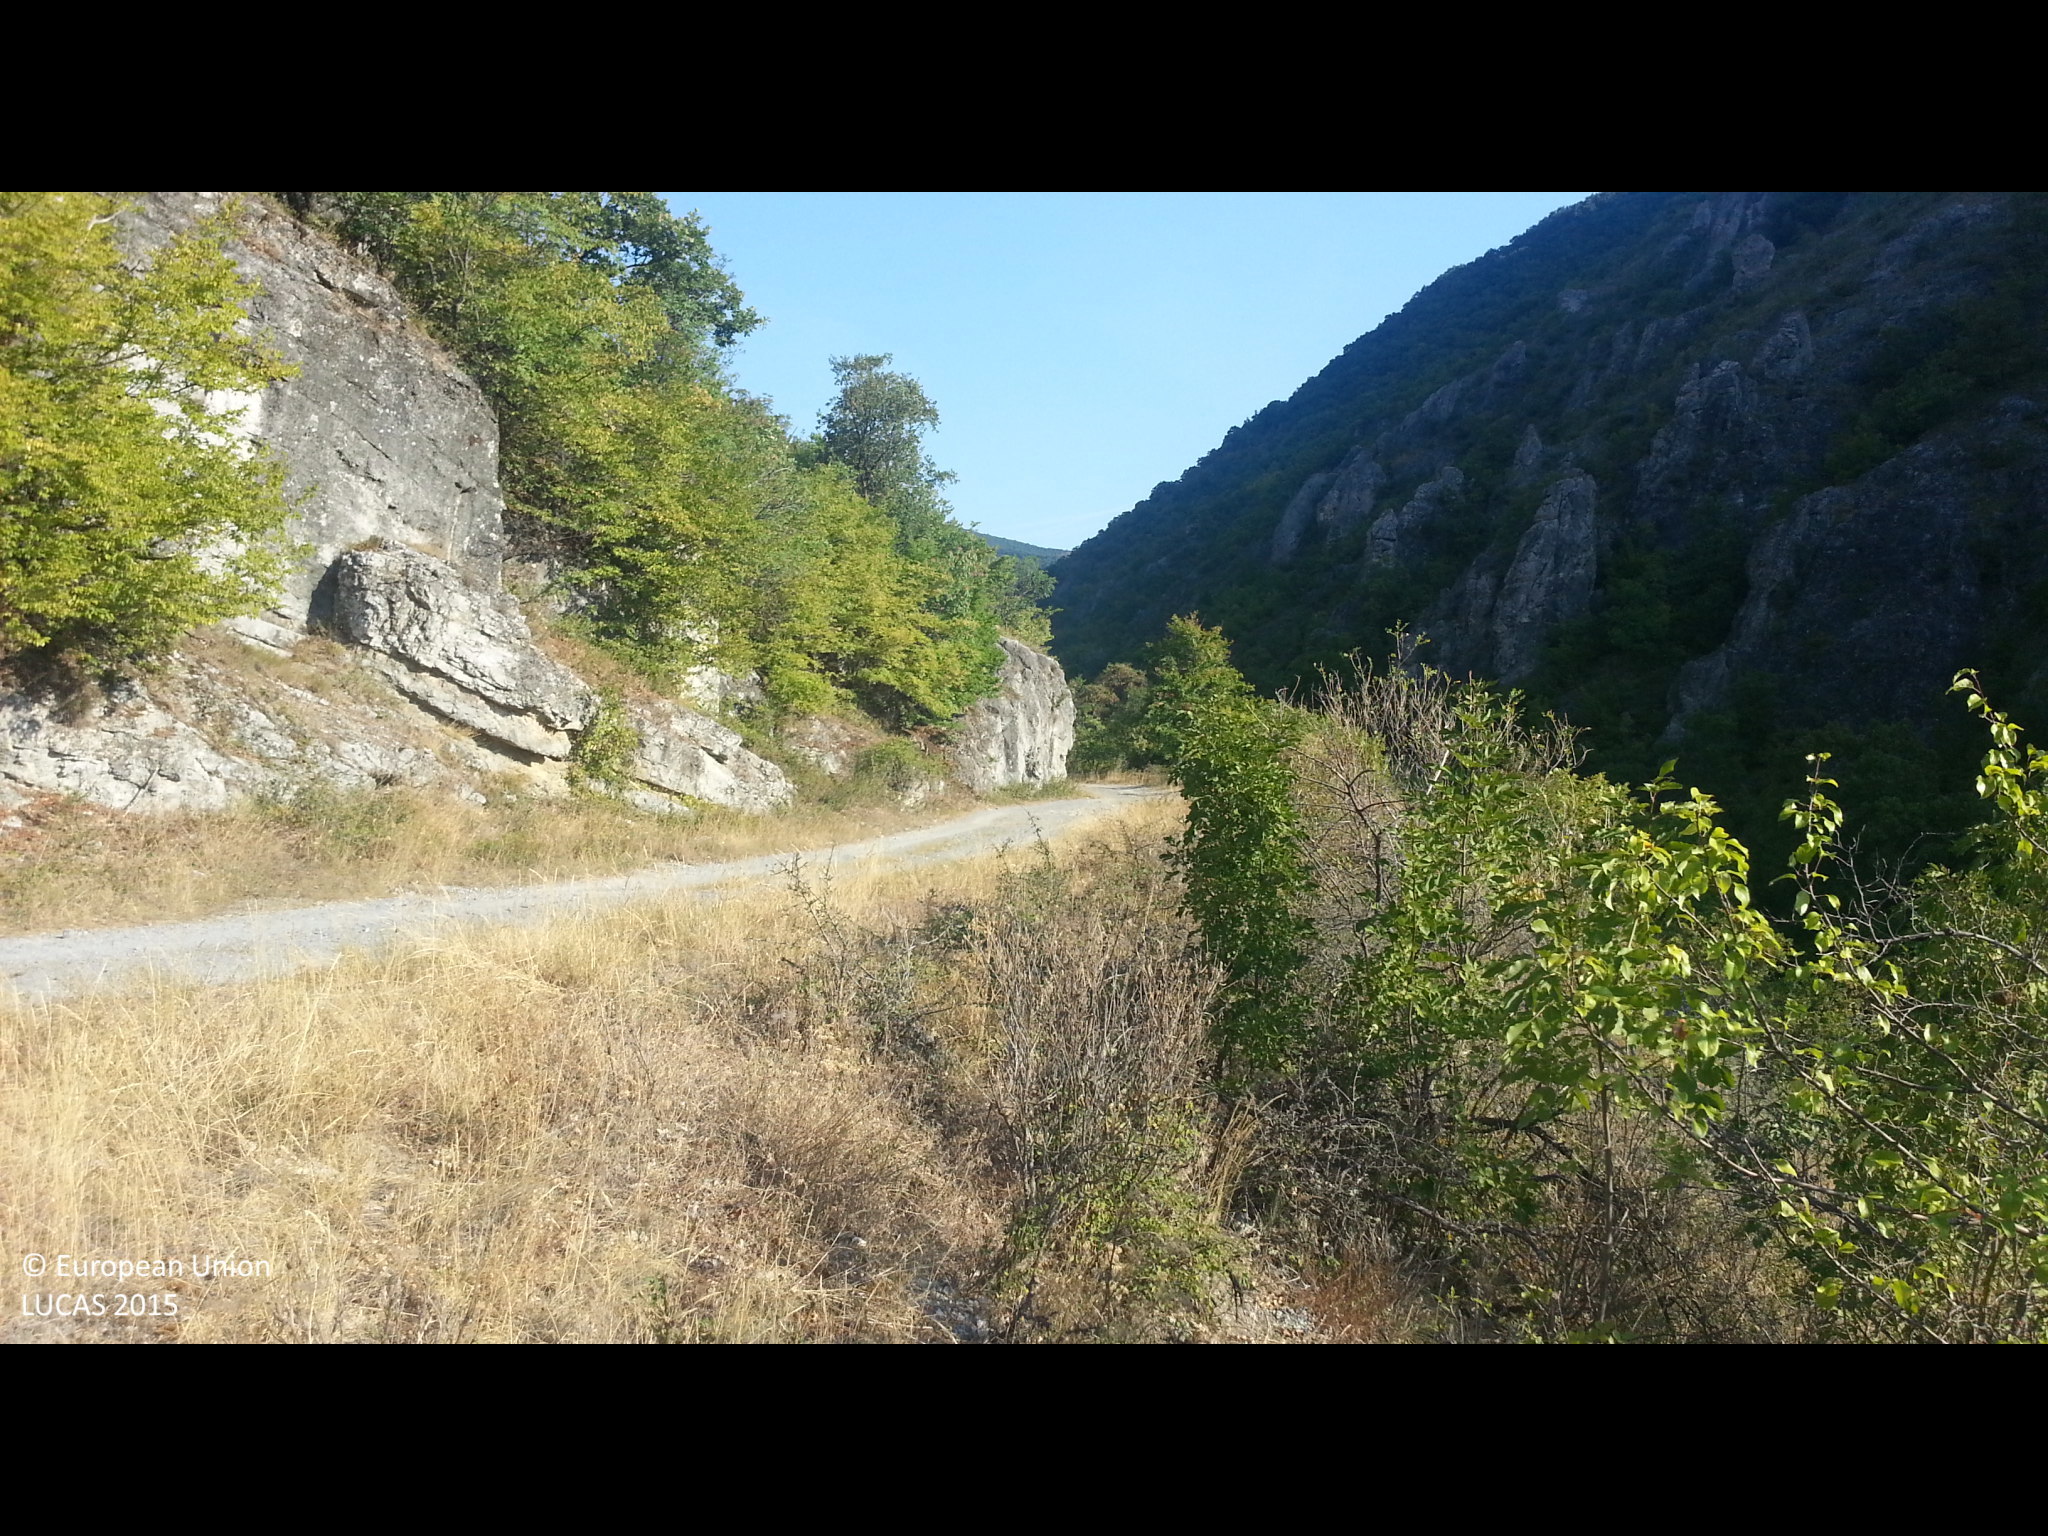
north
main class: Shrubland
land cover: Shrubland with sparse tree cover
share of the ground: 50 - 75 %
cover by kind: shrubs 55 %, consolidated bare surface 40 %, broadleaved forest trees 5 %
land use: Semi-natural and natural areas not in use
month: September
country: BG
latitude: 42.3364
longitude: 22.9022
